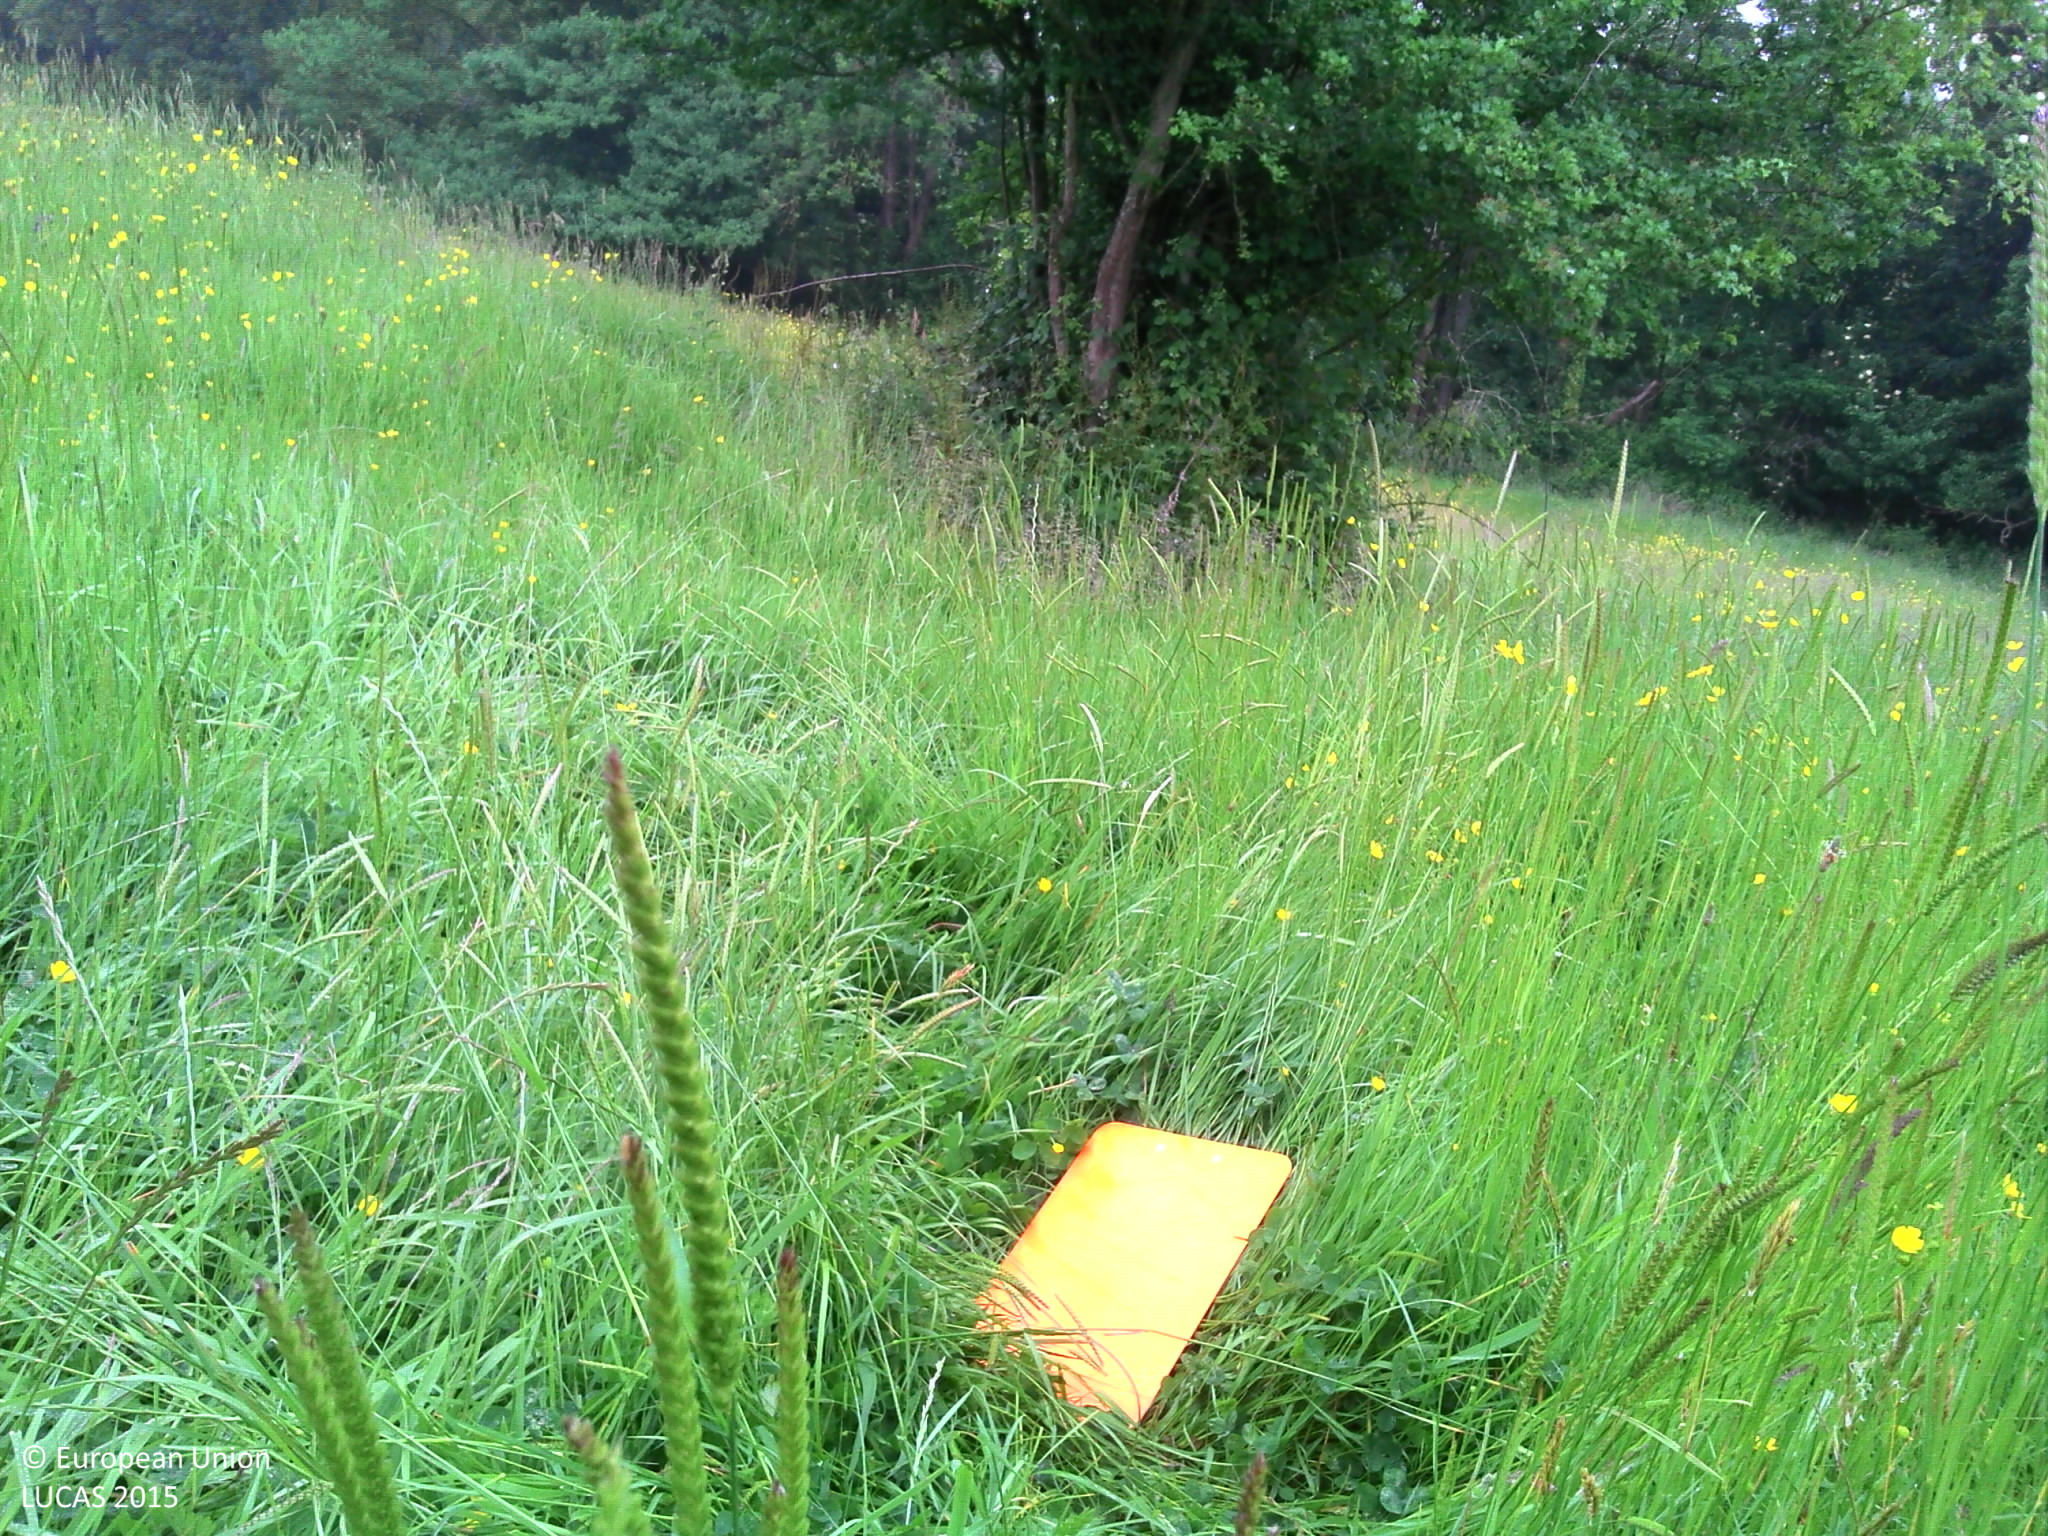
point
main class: Grassland
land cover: Grassland without tree/shrub cover
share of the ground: > 75 %
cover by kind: herbaceous plants 100 %
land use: Agriculture (excluding fallow land and kitchen gardens)
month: June
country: FR
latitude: 49.2549
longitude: 0.0079
